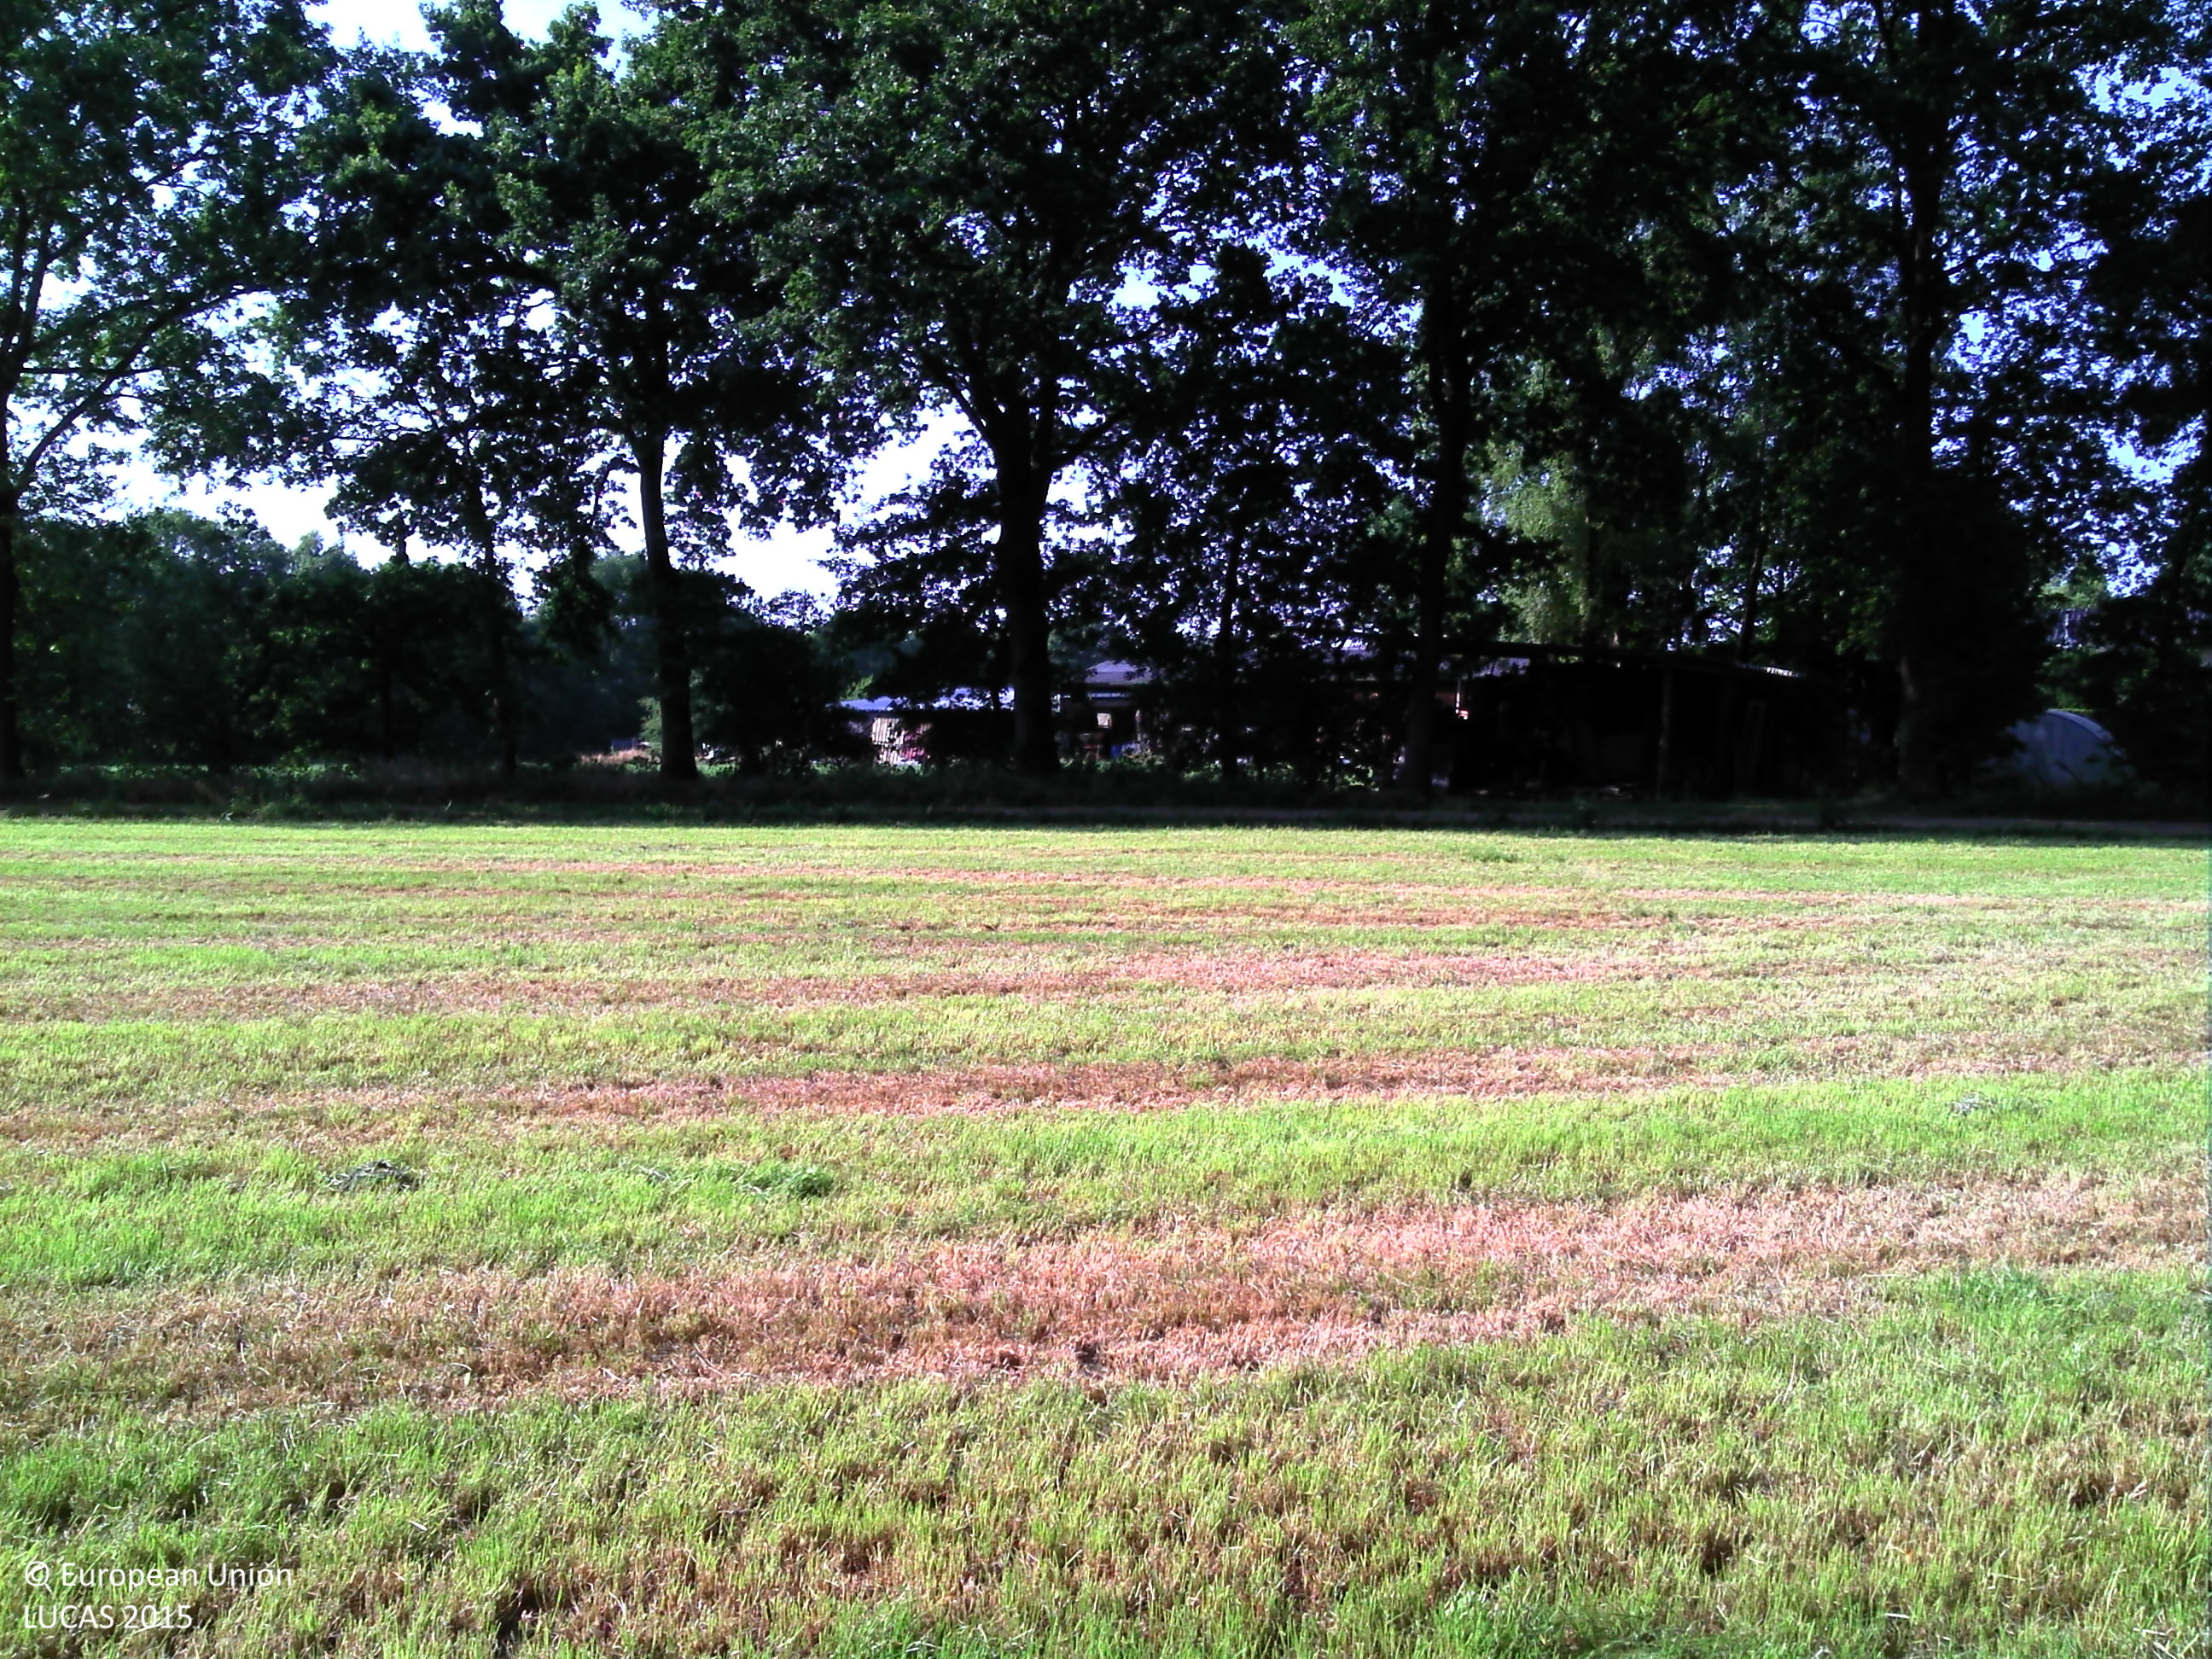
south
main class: Grassland
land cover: Grassland without tree/shrub cover
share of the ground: > 75 %
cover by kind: herbaceous plants 100 %
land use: Agriculture (excluding fallow land and kitchen gardens)
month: July
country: BE
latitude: 51.1039
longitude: 5.4994
